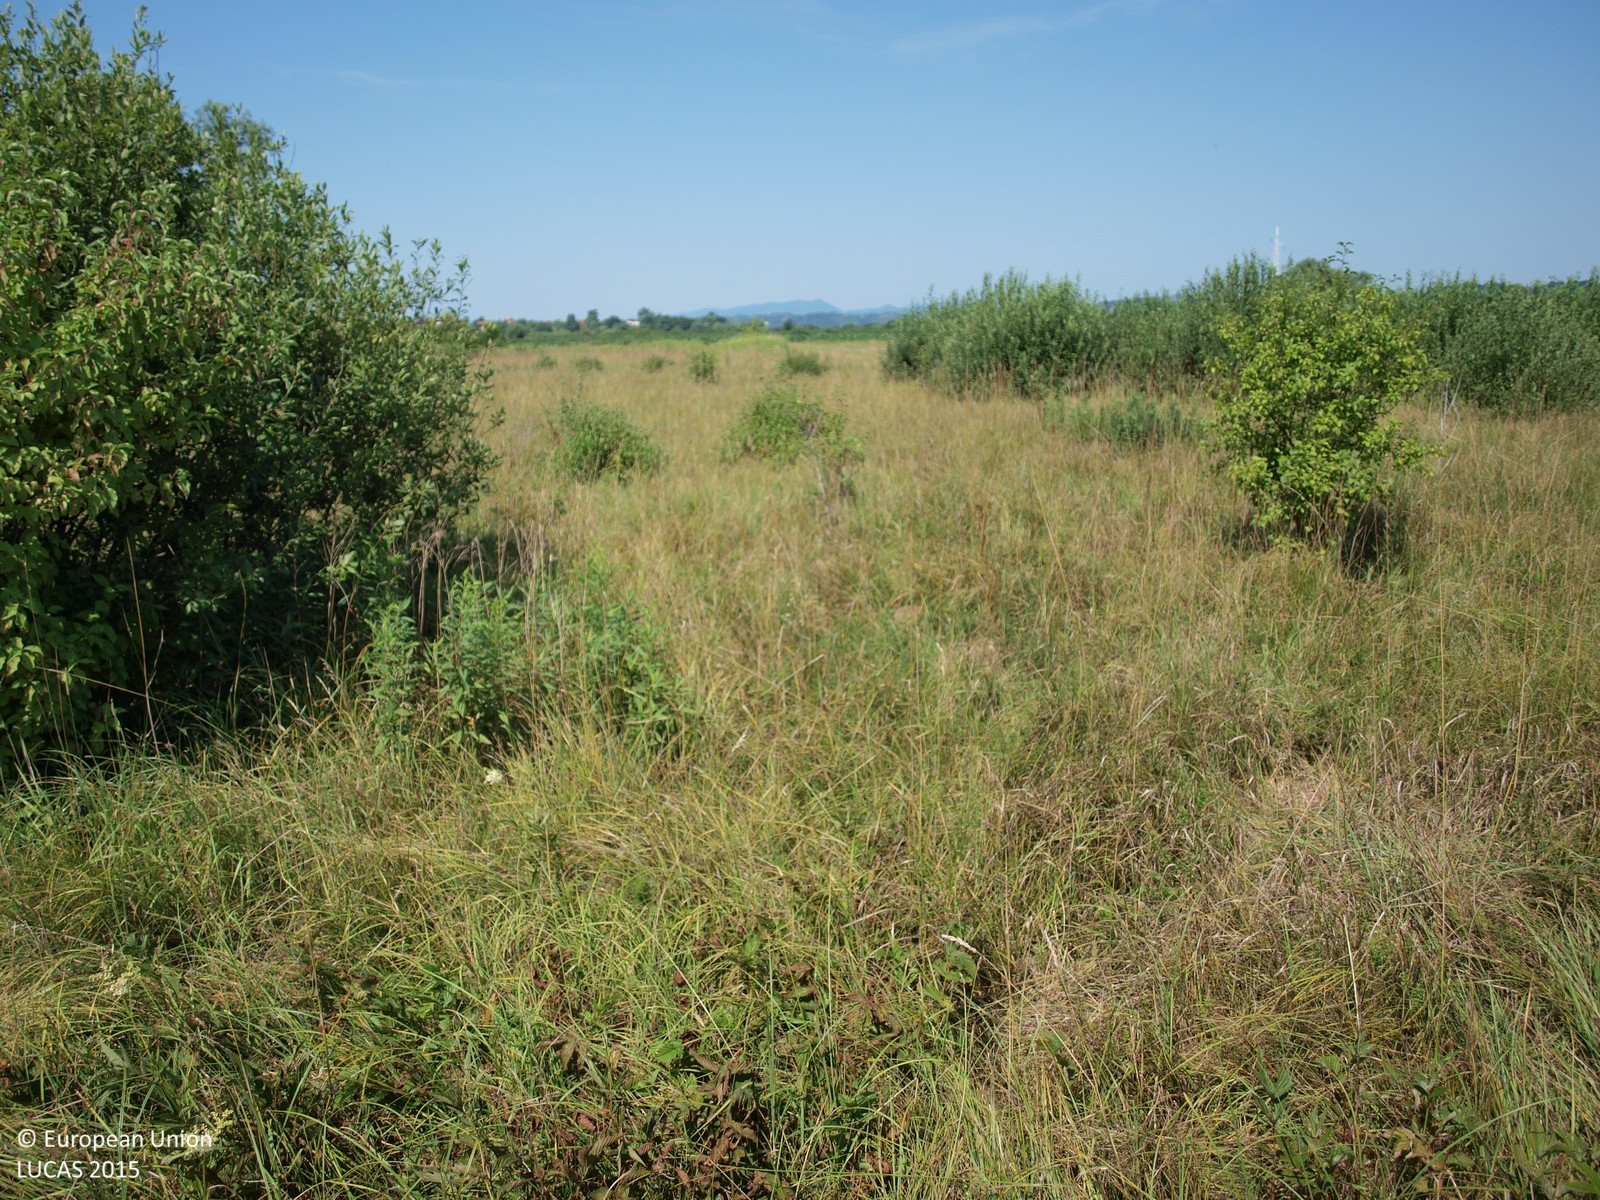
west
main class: Grassland
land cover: Grassland with sparse tree/shrub cover
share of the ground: > 75 %
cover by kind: herbaceous plants 95 %, broadleaved forest trees 5 %
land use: Abandoned areas
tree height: < 5 m
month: July
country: HR
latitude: 46.0063
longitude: 15.9258
